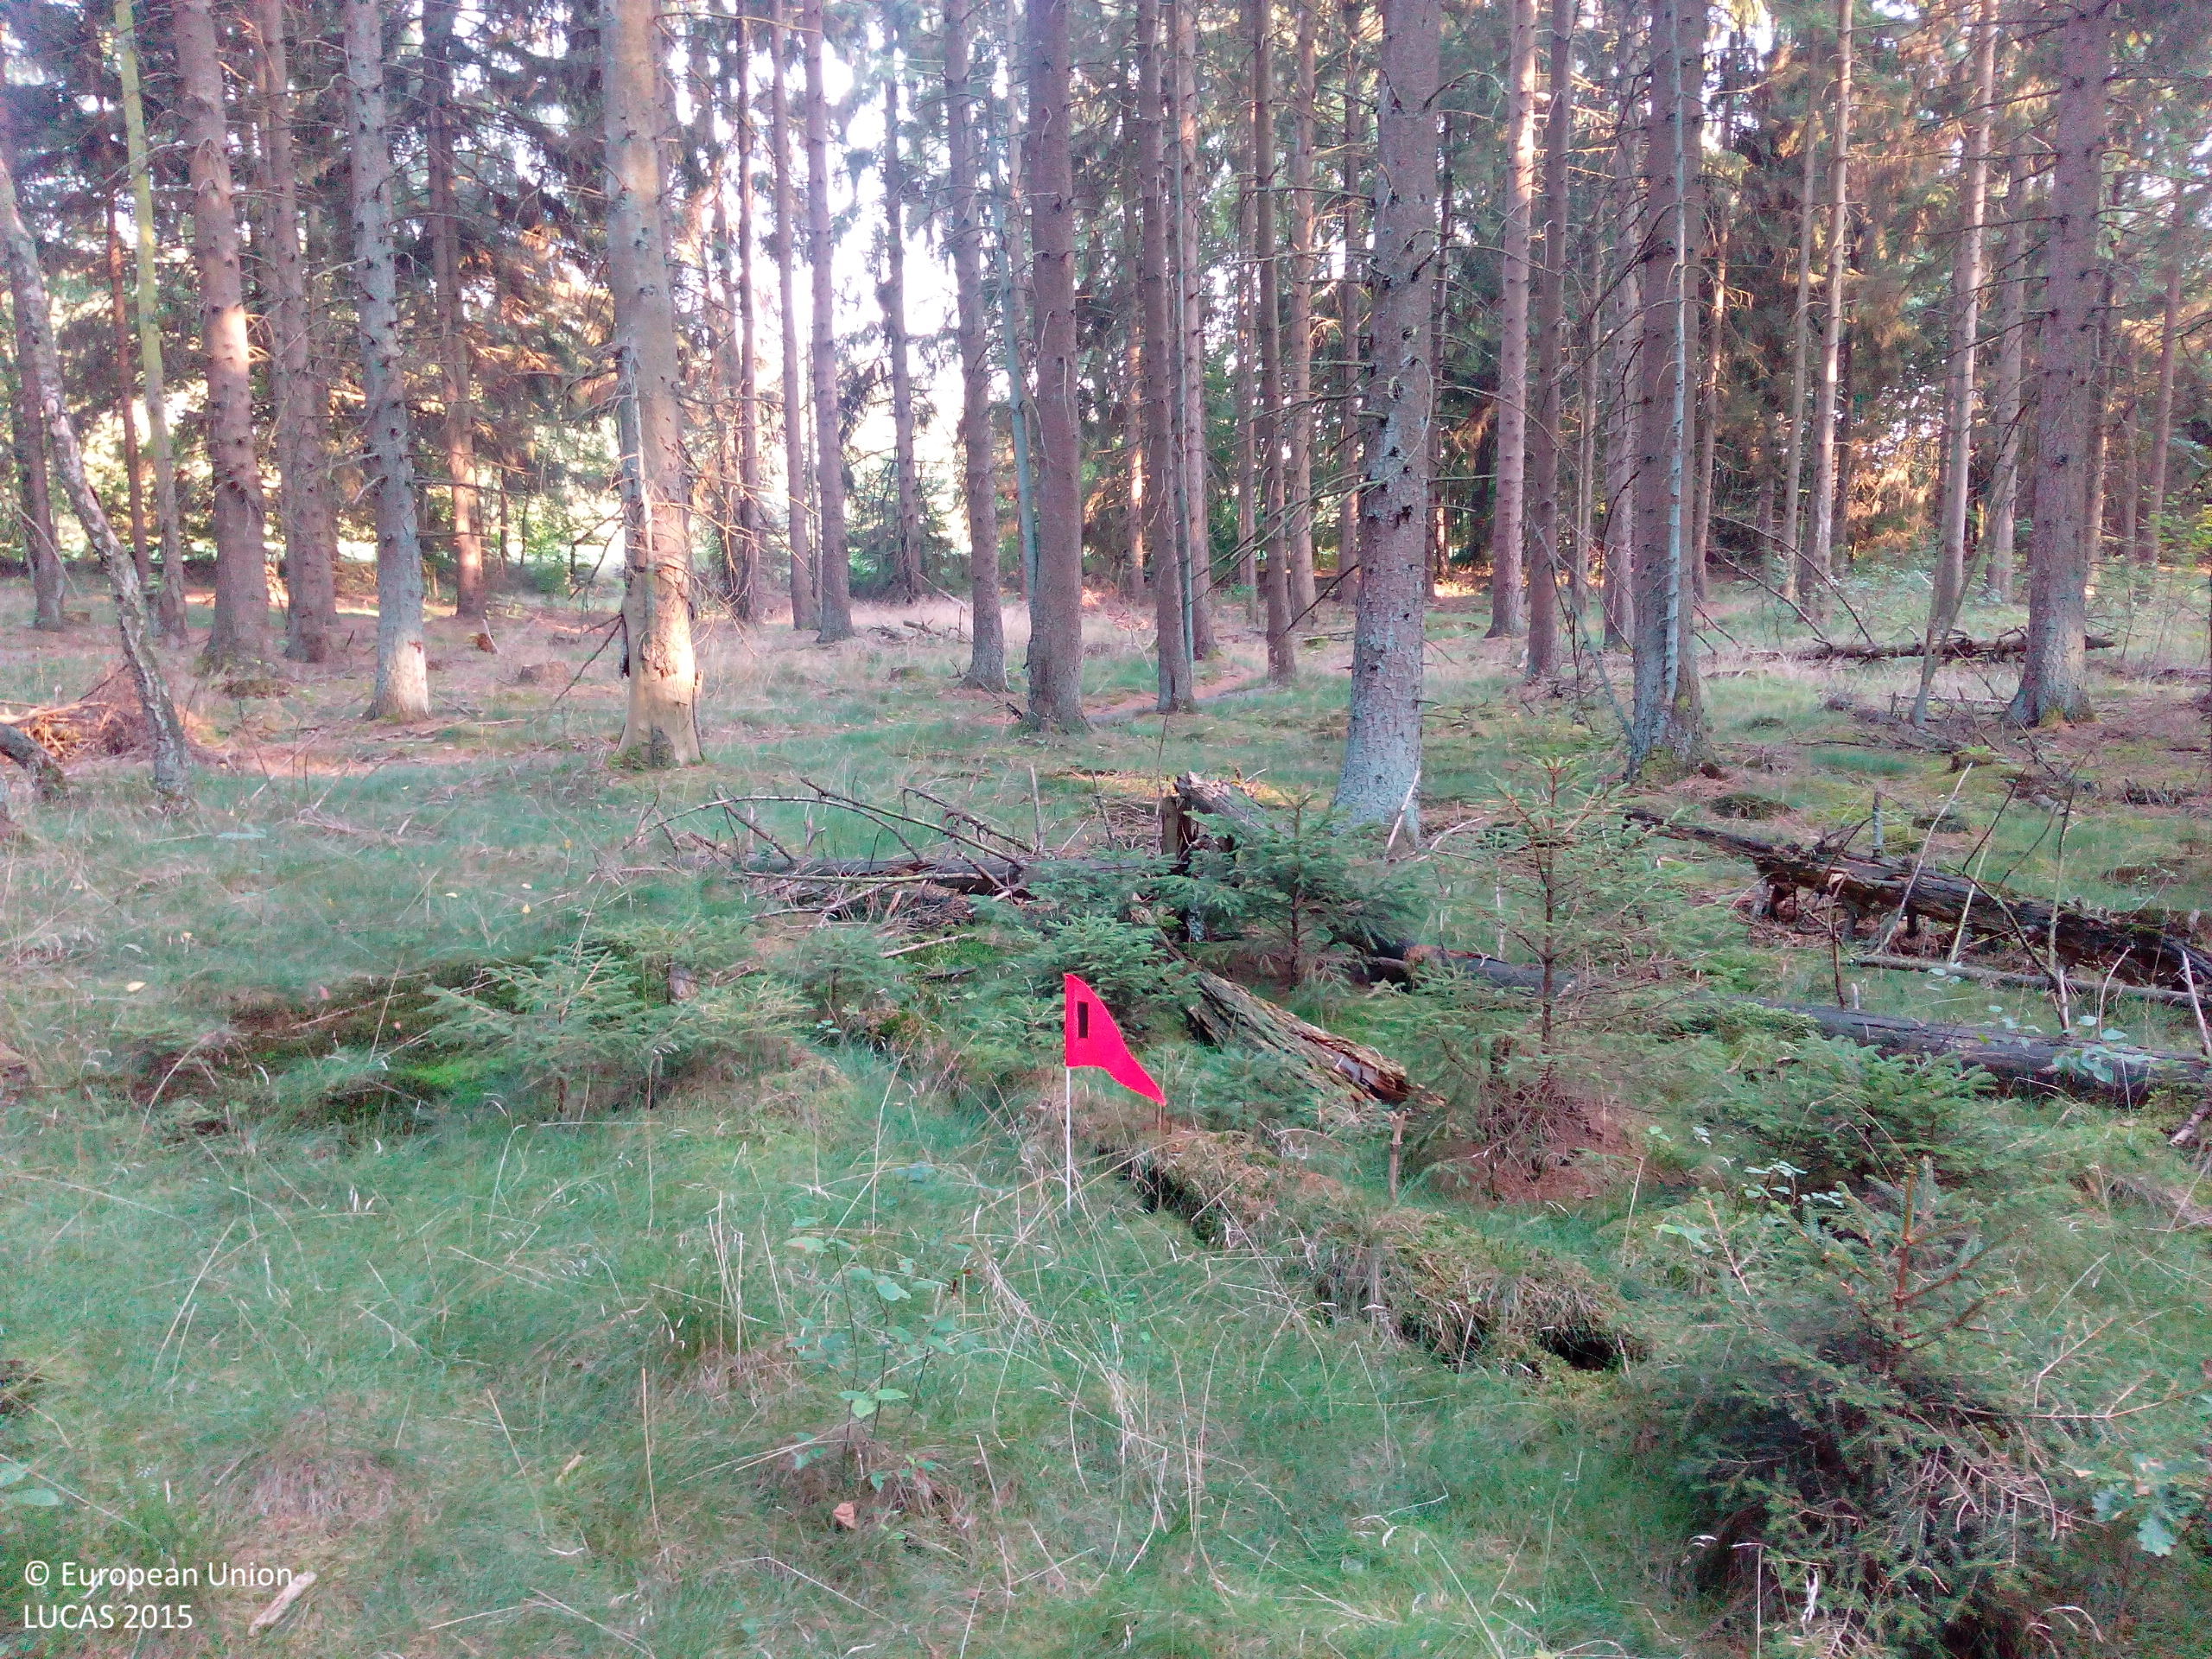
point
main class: Woodland
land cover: Spruce dominated coniferous woodland
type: hemiboreal forest and nemoral coniferous forest and mixed broadleaved-coniferous forest
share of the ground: > 75 %
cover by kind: coniferous forest trees 75 %, herbaceous plants 20 %, unconsolidated bare surface 5 %
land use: Forestry
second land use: Amenities, museums, leisure
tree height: > 5 m
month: August
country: DE
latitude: 53.8152
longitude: 9.8937
